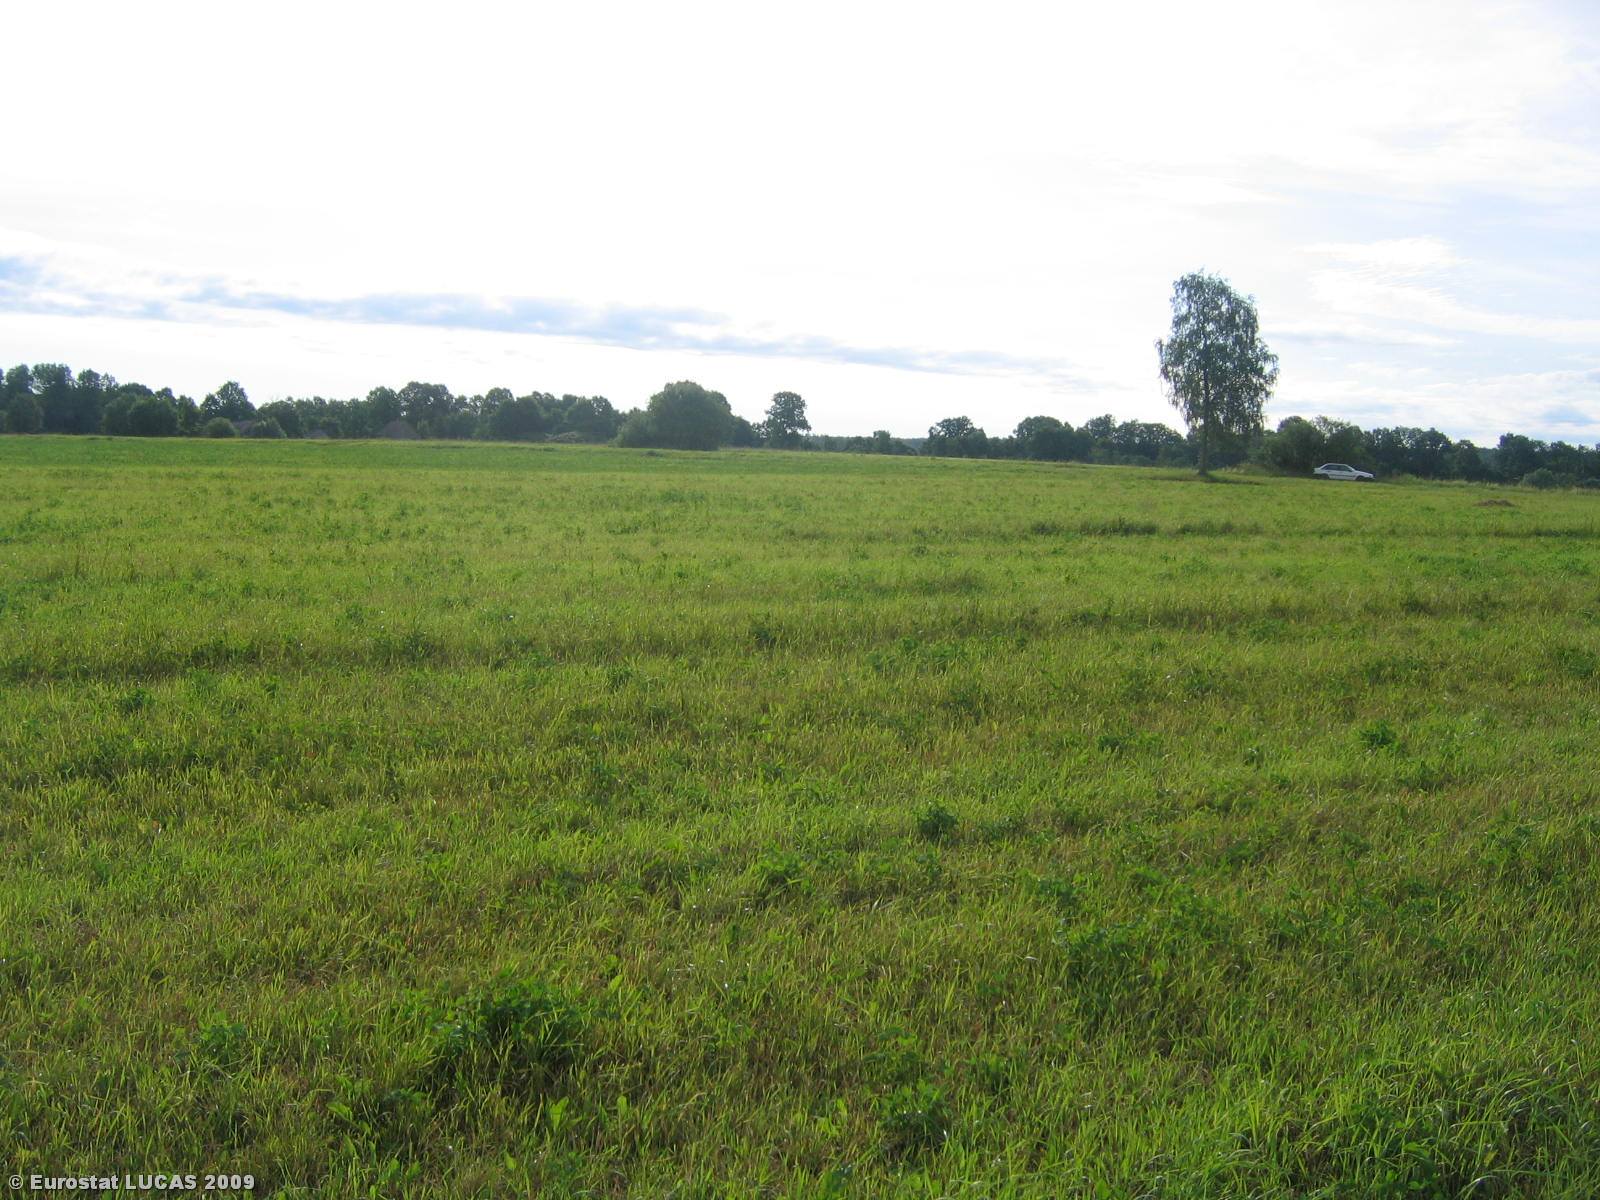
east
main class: Grassland
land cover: Grassland without tree/shrub cover
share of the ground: > 75 %
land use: Agriculture (excluding fallow land and kitchen gardens)
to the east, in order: Grassland without tree/shrub cover; Paved roads, cycling and walking lanes; Grass margins; Barley; Grassland without tree/shrub cover
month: July
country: LT
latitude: 55.3324
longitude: 22.7236
